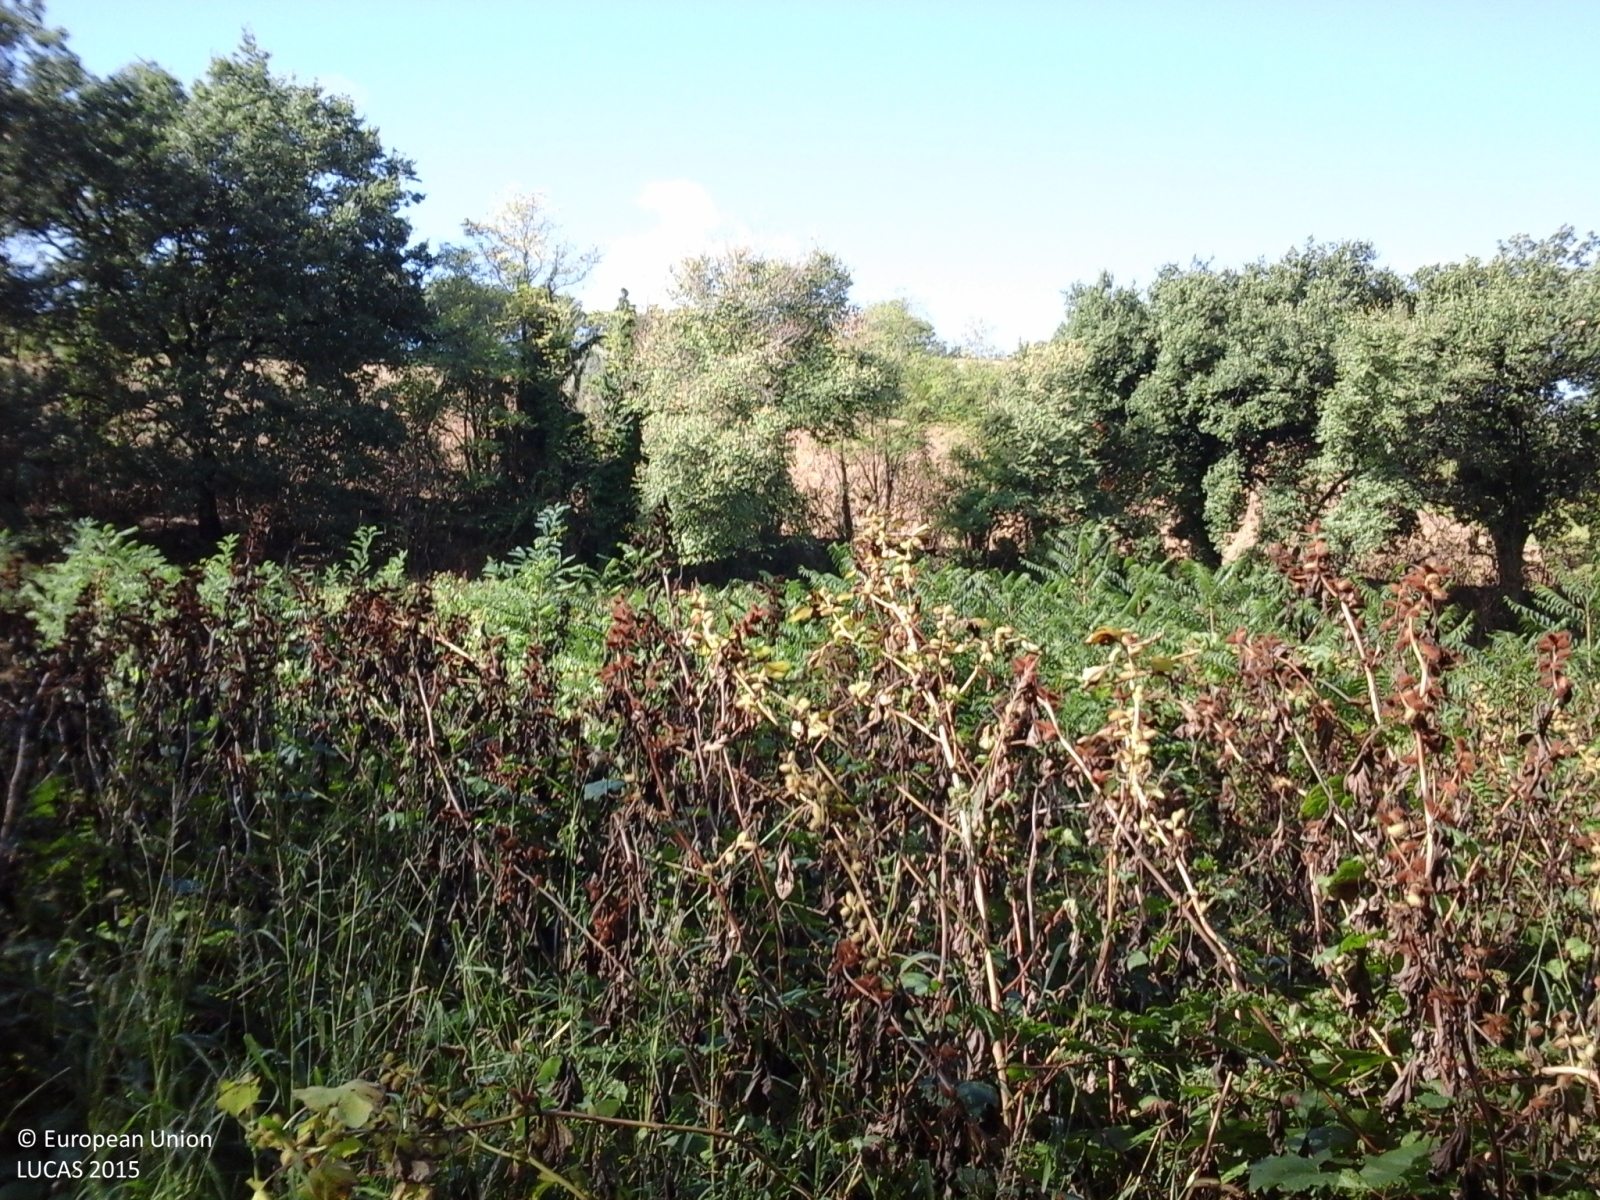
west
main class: Woodland
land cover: Broadleaved woodland
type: thermophilous deciduous forest
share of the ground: > 75 %
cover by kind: broadleaved forest trees 100 %
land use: Forestry
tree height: > 5 m
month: October
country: IT
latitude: 43.5727
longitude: 13.3970
